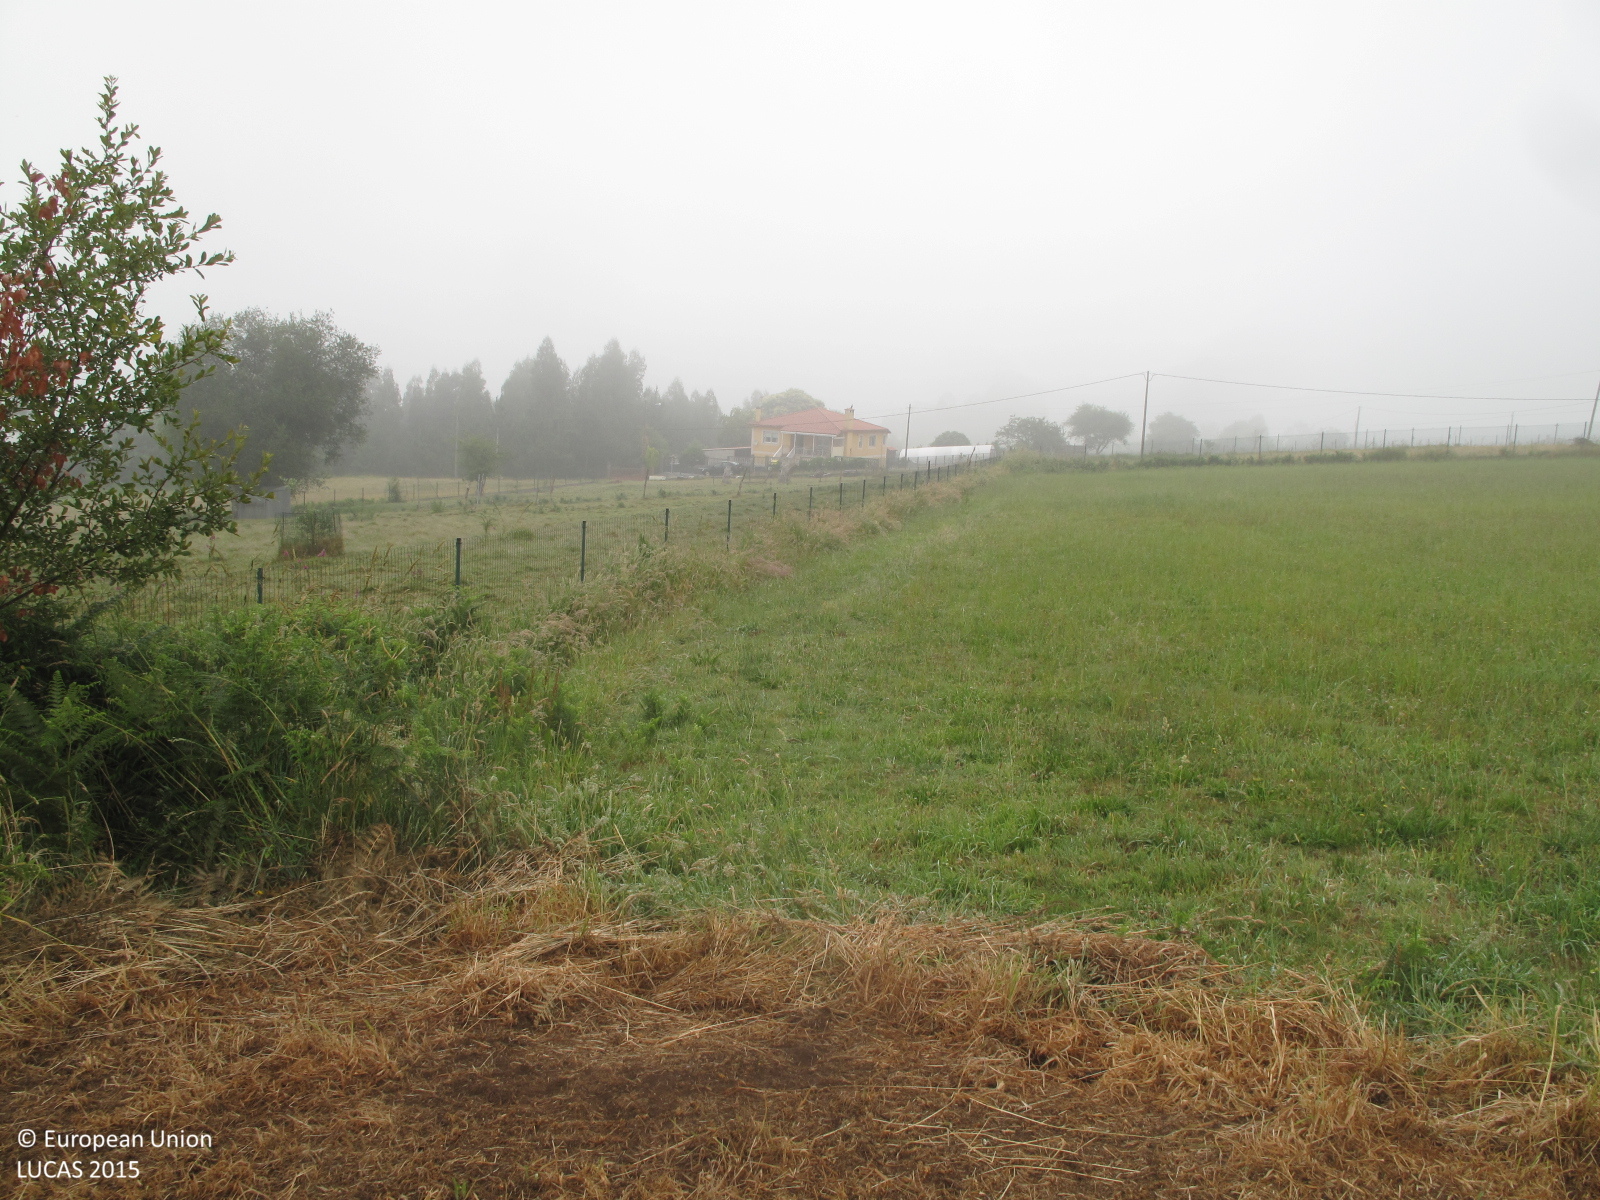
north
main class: Grassland
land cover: Grassland without tree/shrub cover
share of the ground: > 75 %
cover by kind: herbaceous plants 80 %, unconsolidated bare surface 20 %
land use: Agriculture (excluding fallow land and kitchen gardens)
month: June
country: ES
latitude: 43.1775
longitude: -8.2452
